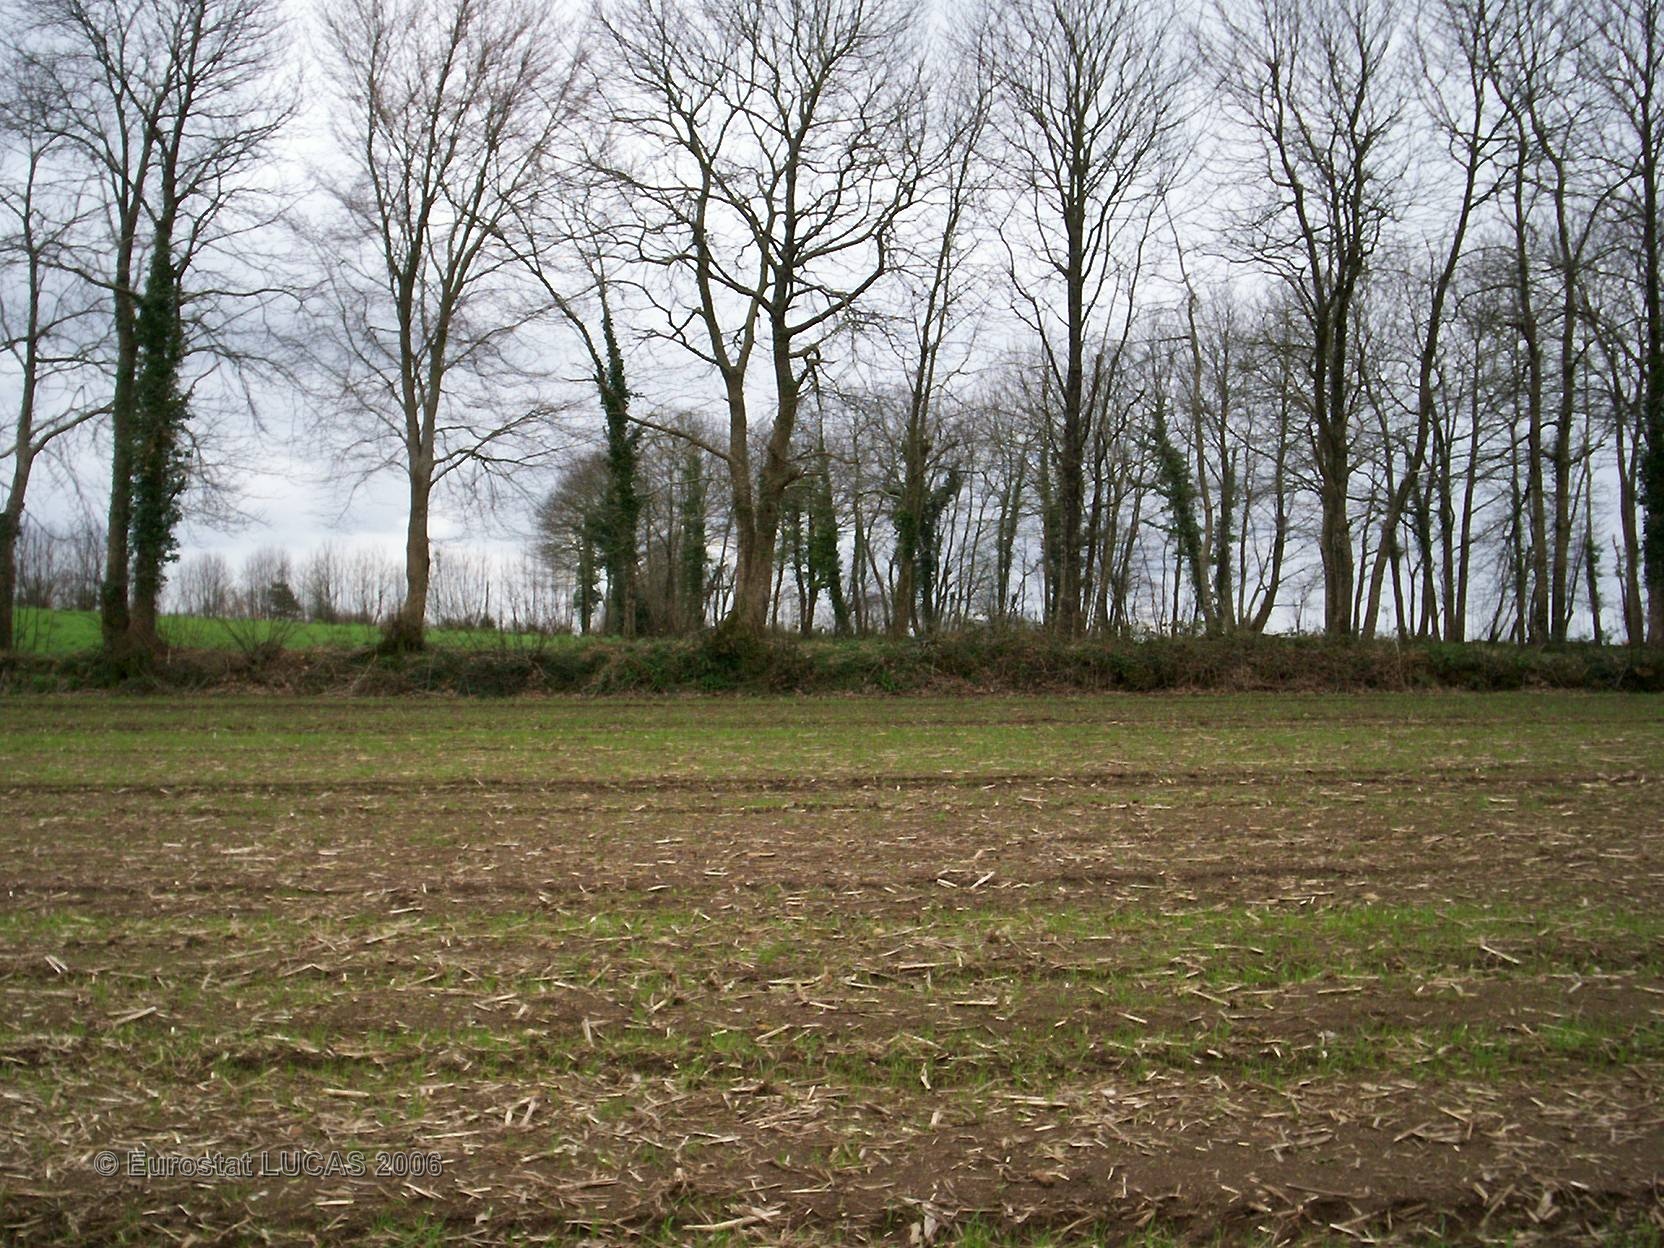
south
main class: Grassland
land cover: Grassland without tree/shrub cover
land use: Agriculture (excluding fallow land and kitchen gardens)
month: April
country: FR
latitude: 47.9674
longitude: -3.5383
